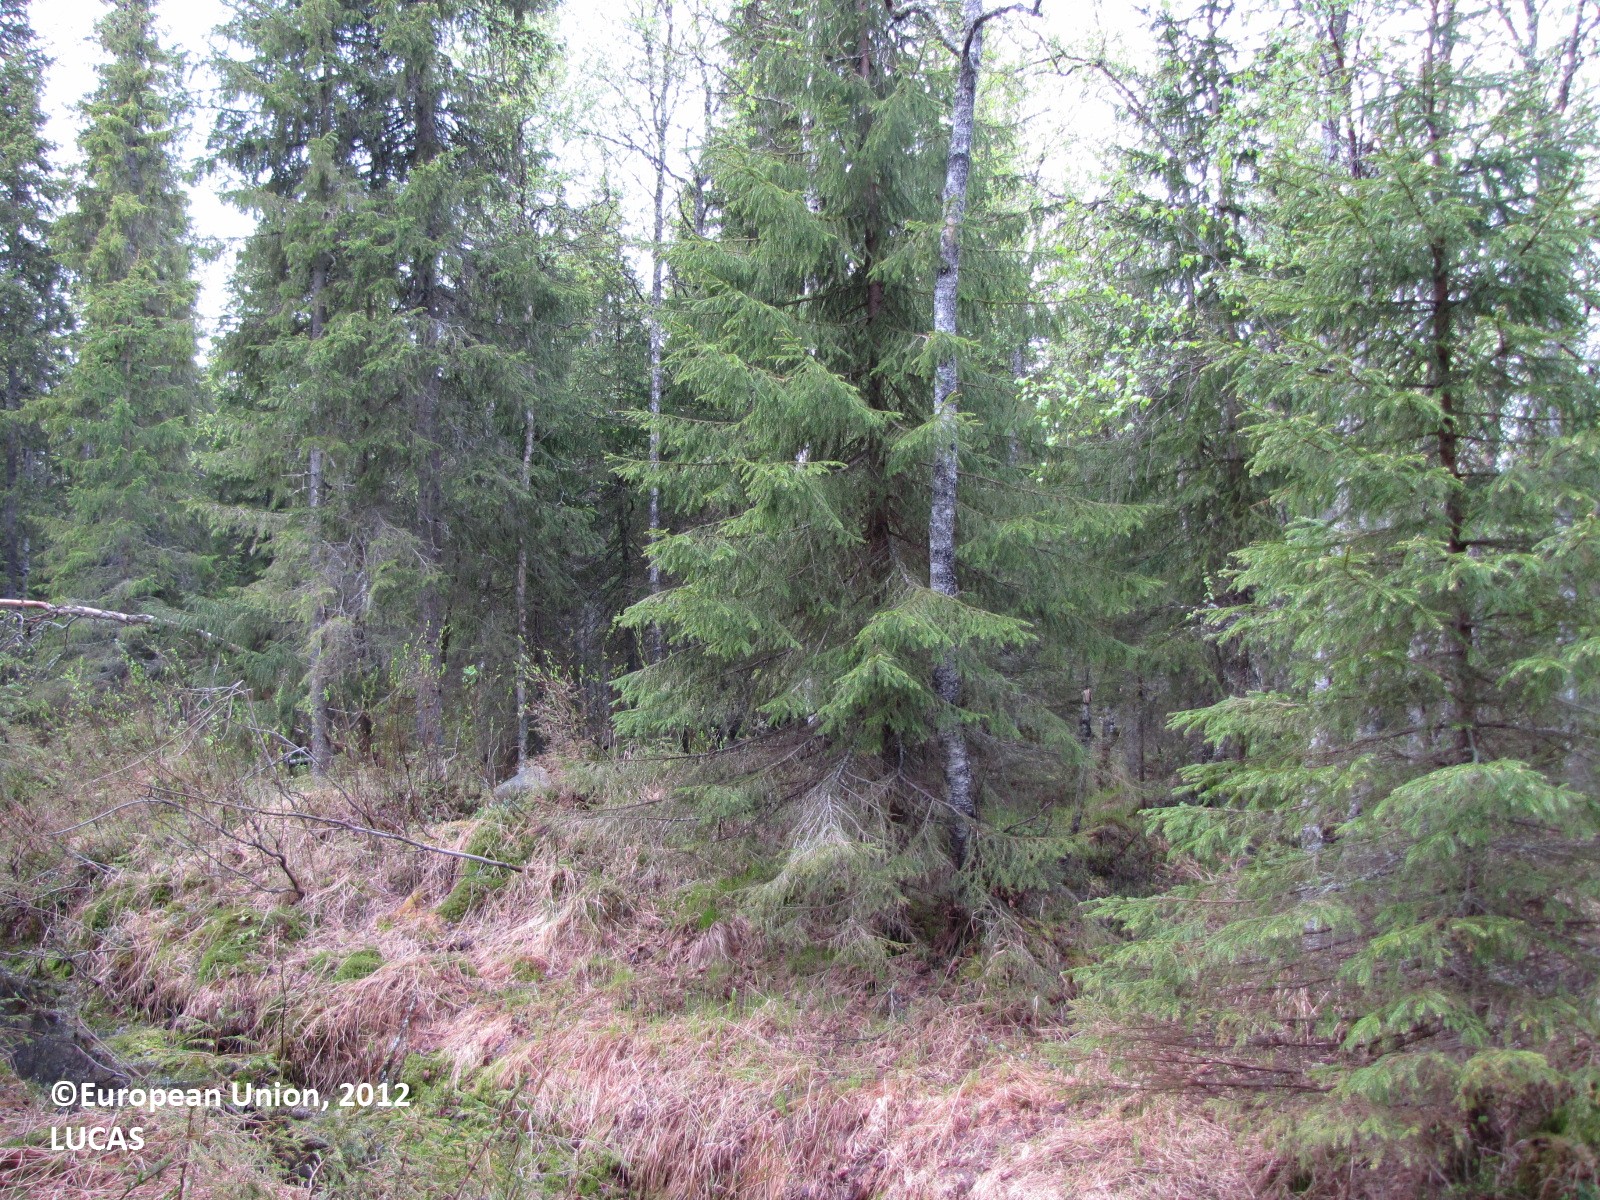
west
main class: Woodland
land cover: Spruce dominated coniferous woodland
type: boreal forest
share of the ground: 50 - 75 %
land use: Forestry
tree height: > 5 m
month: June
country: FI
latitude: 65.9324
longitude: 24.1764
